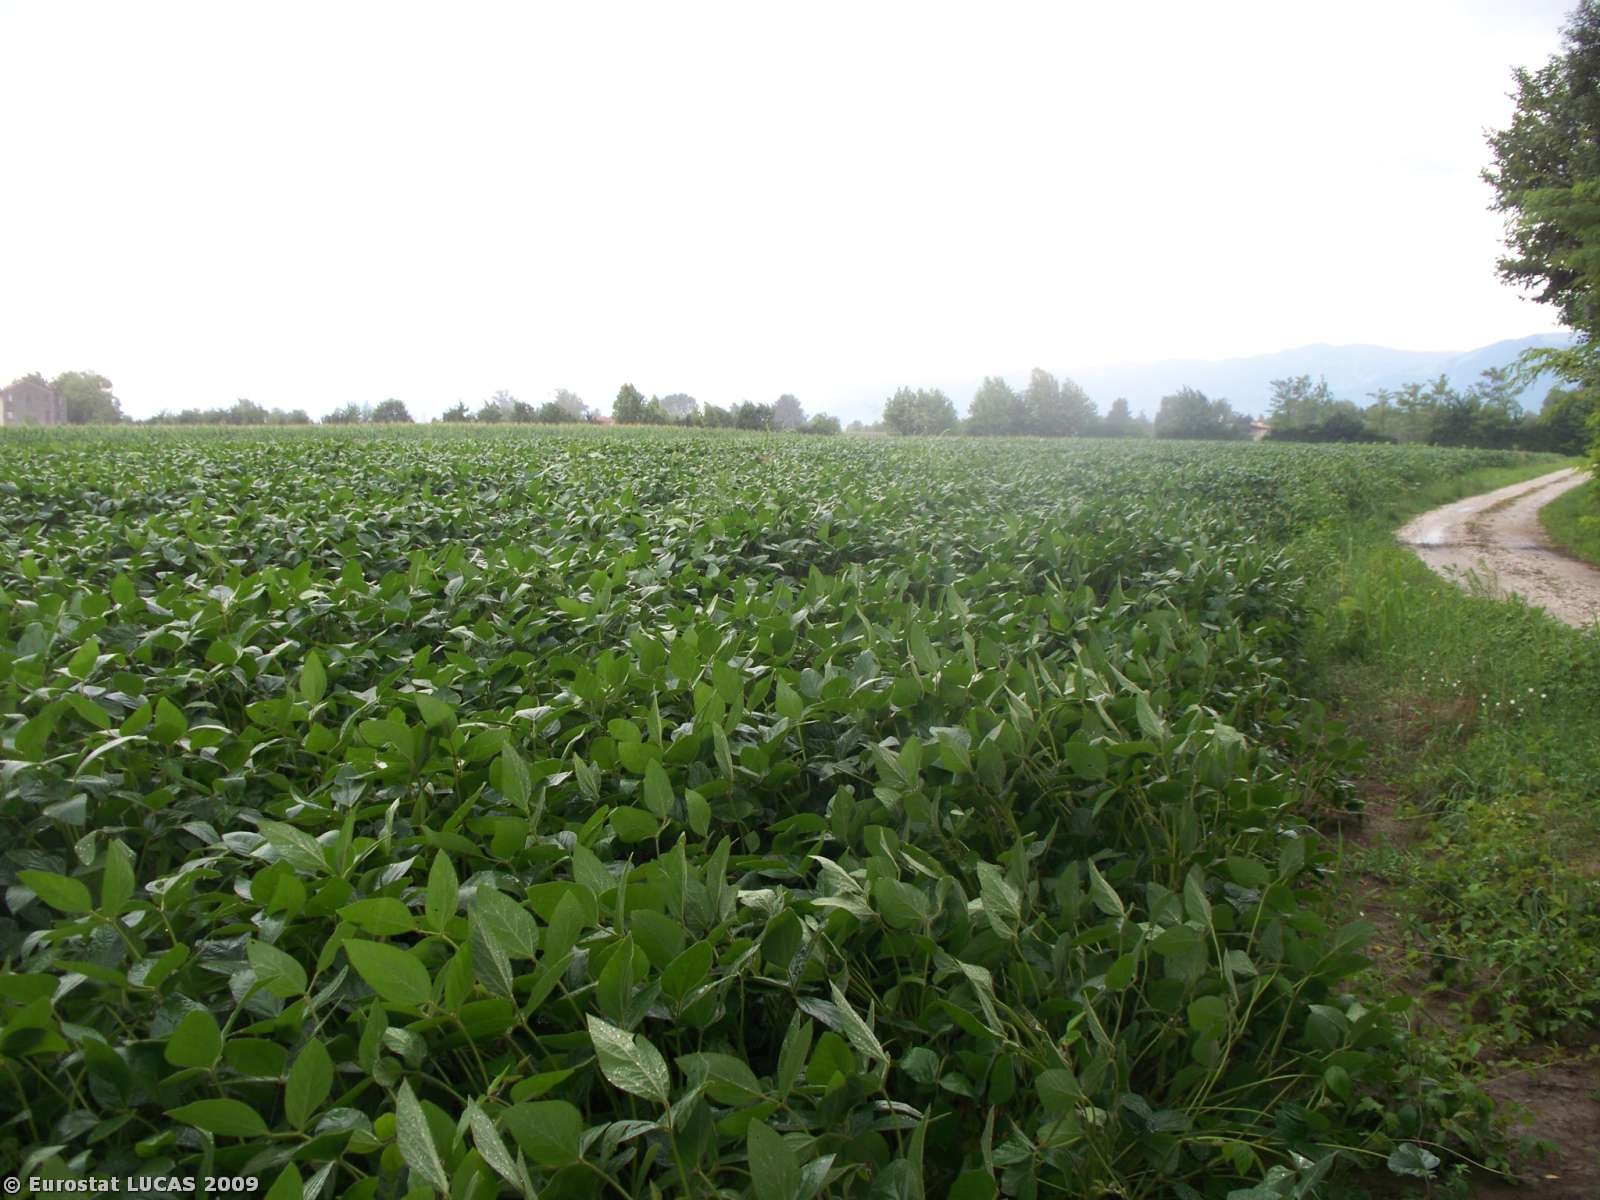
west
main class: Cropland
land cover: Soya
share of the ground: > 75 %
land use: Agriculture (excluding fallow land and kitchen gardens)
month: July
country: IT
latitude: 45.8712
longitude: 12.5087
